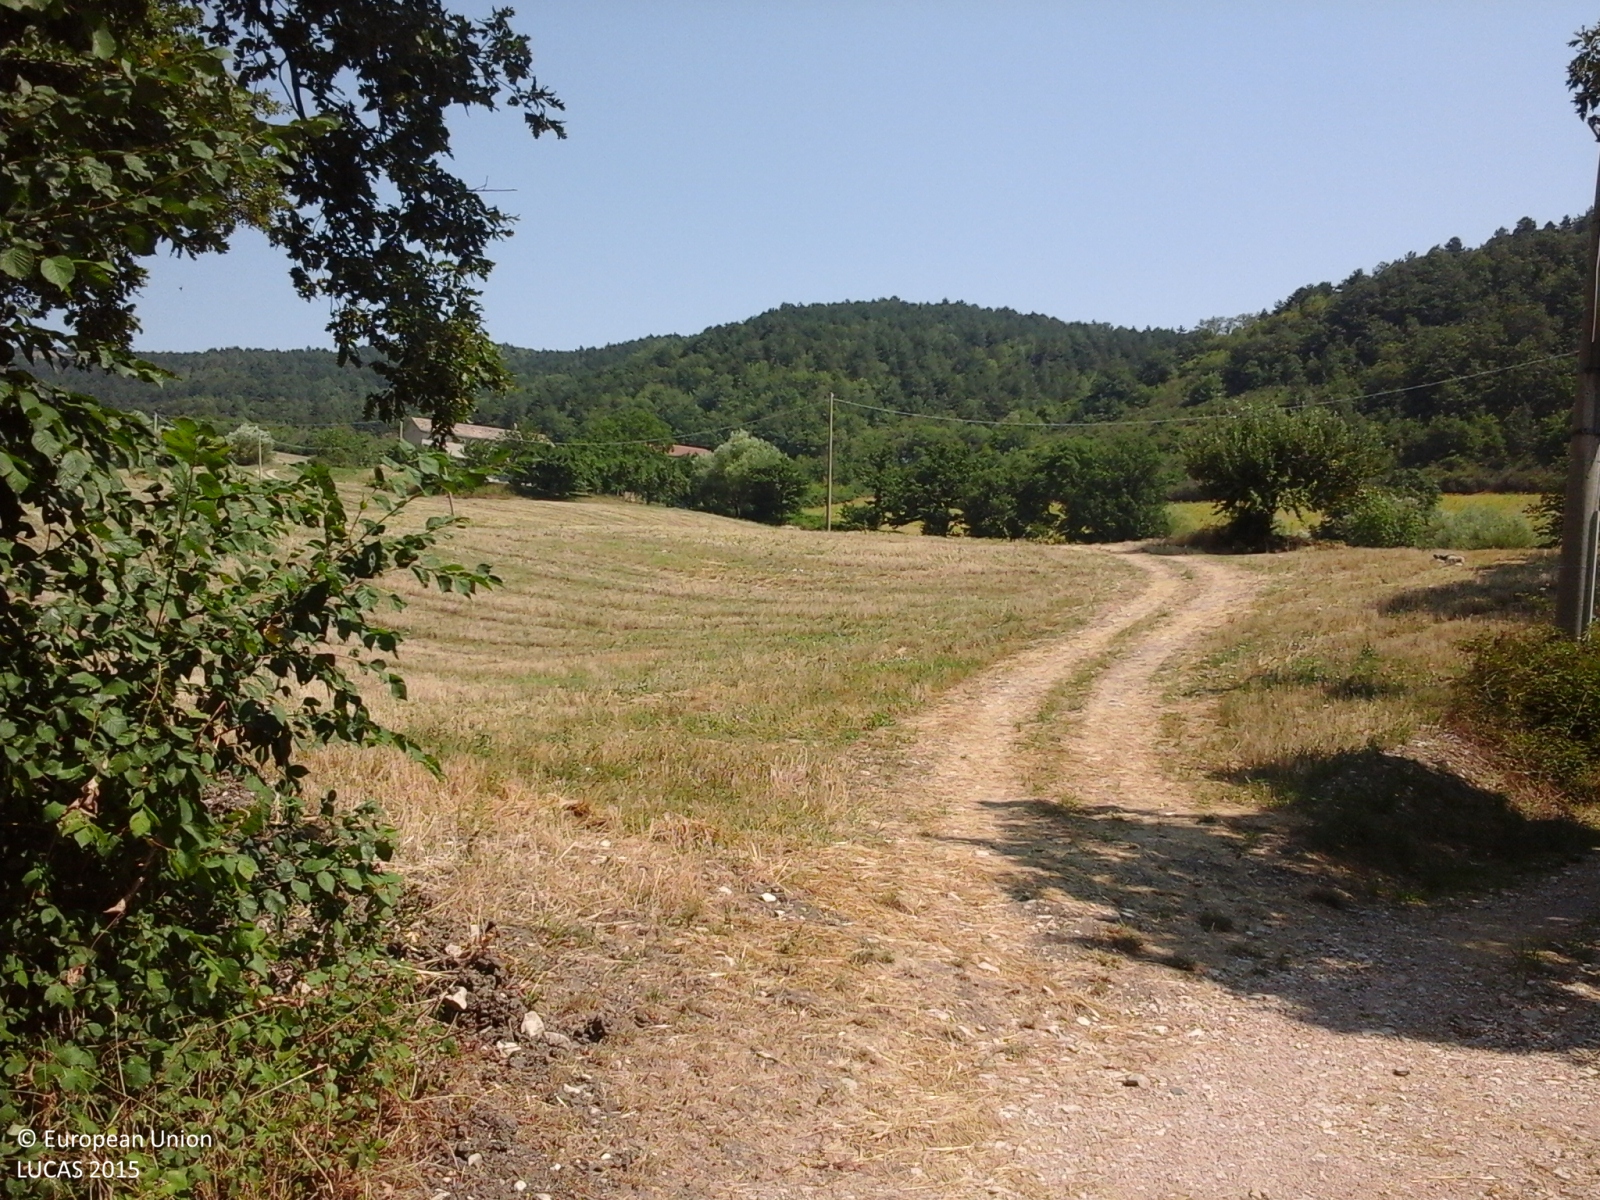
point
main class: Cropland
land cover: Durum wheat
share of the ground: > 75 %
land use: Agriculture (excluding fallow land and kitchen gardens)
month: August
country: IT
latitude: 41.3460
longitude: 15.1569
